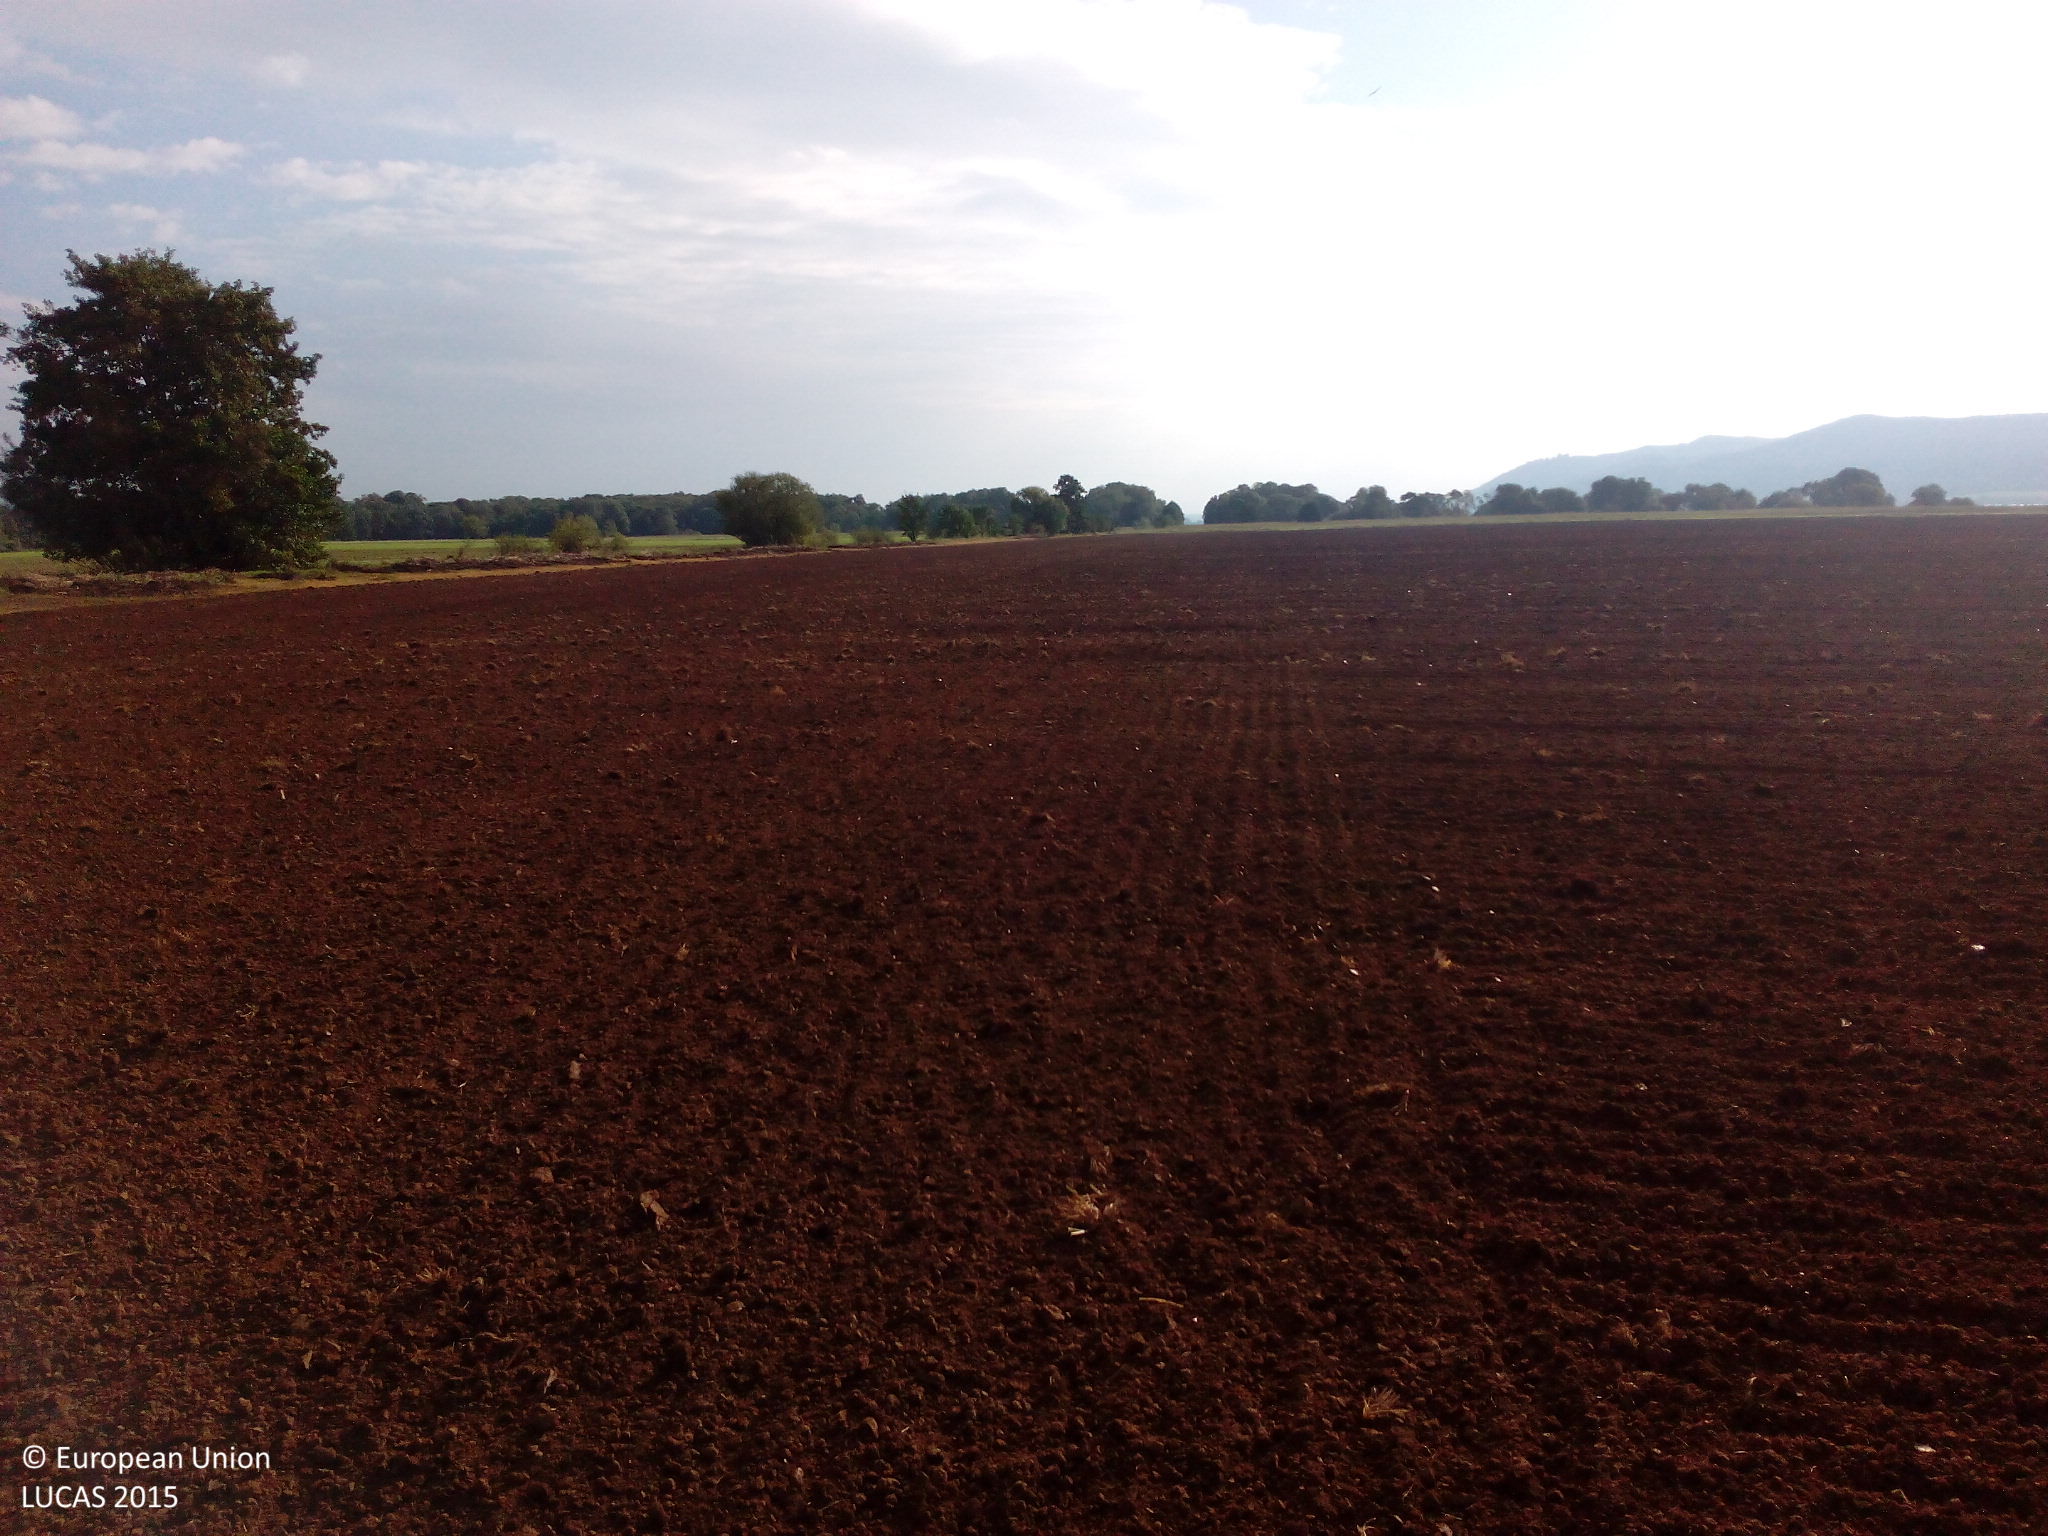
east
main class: Cropland
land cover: Barley
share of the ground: < 10 %
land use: Agriculture (excluding fallow land and kitchen gardens)
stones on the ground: < 10 %
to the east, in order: Barley
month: September
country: DE
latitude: 51.4388
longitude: 10.9636
